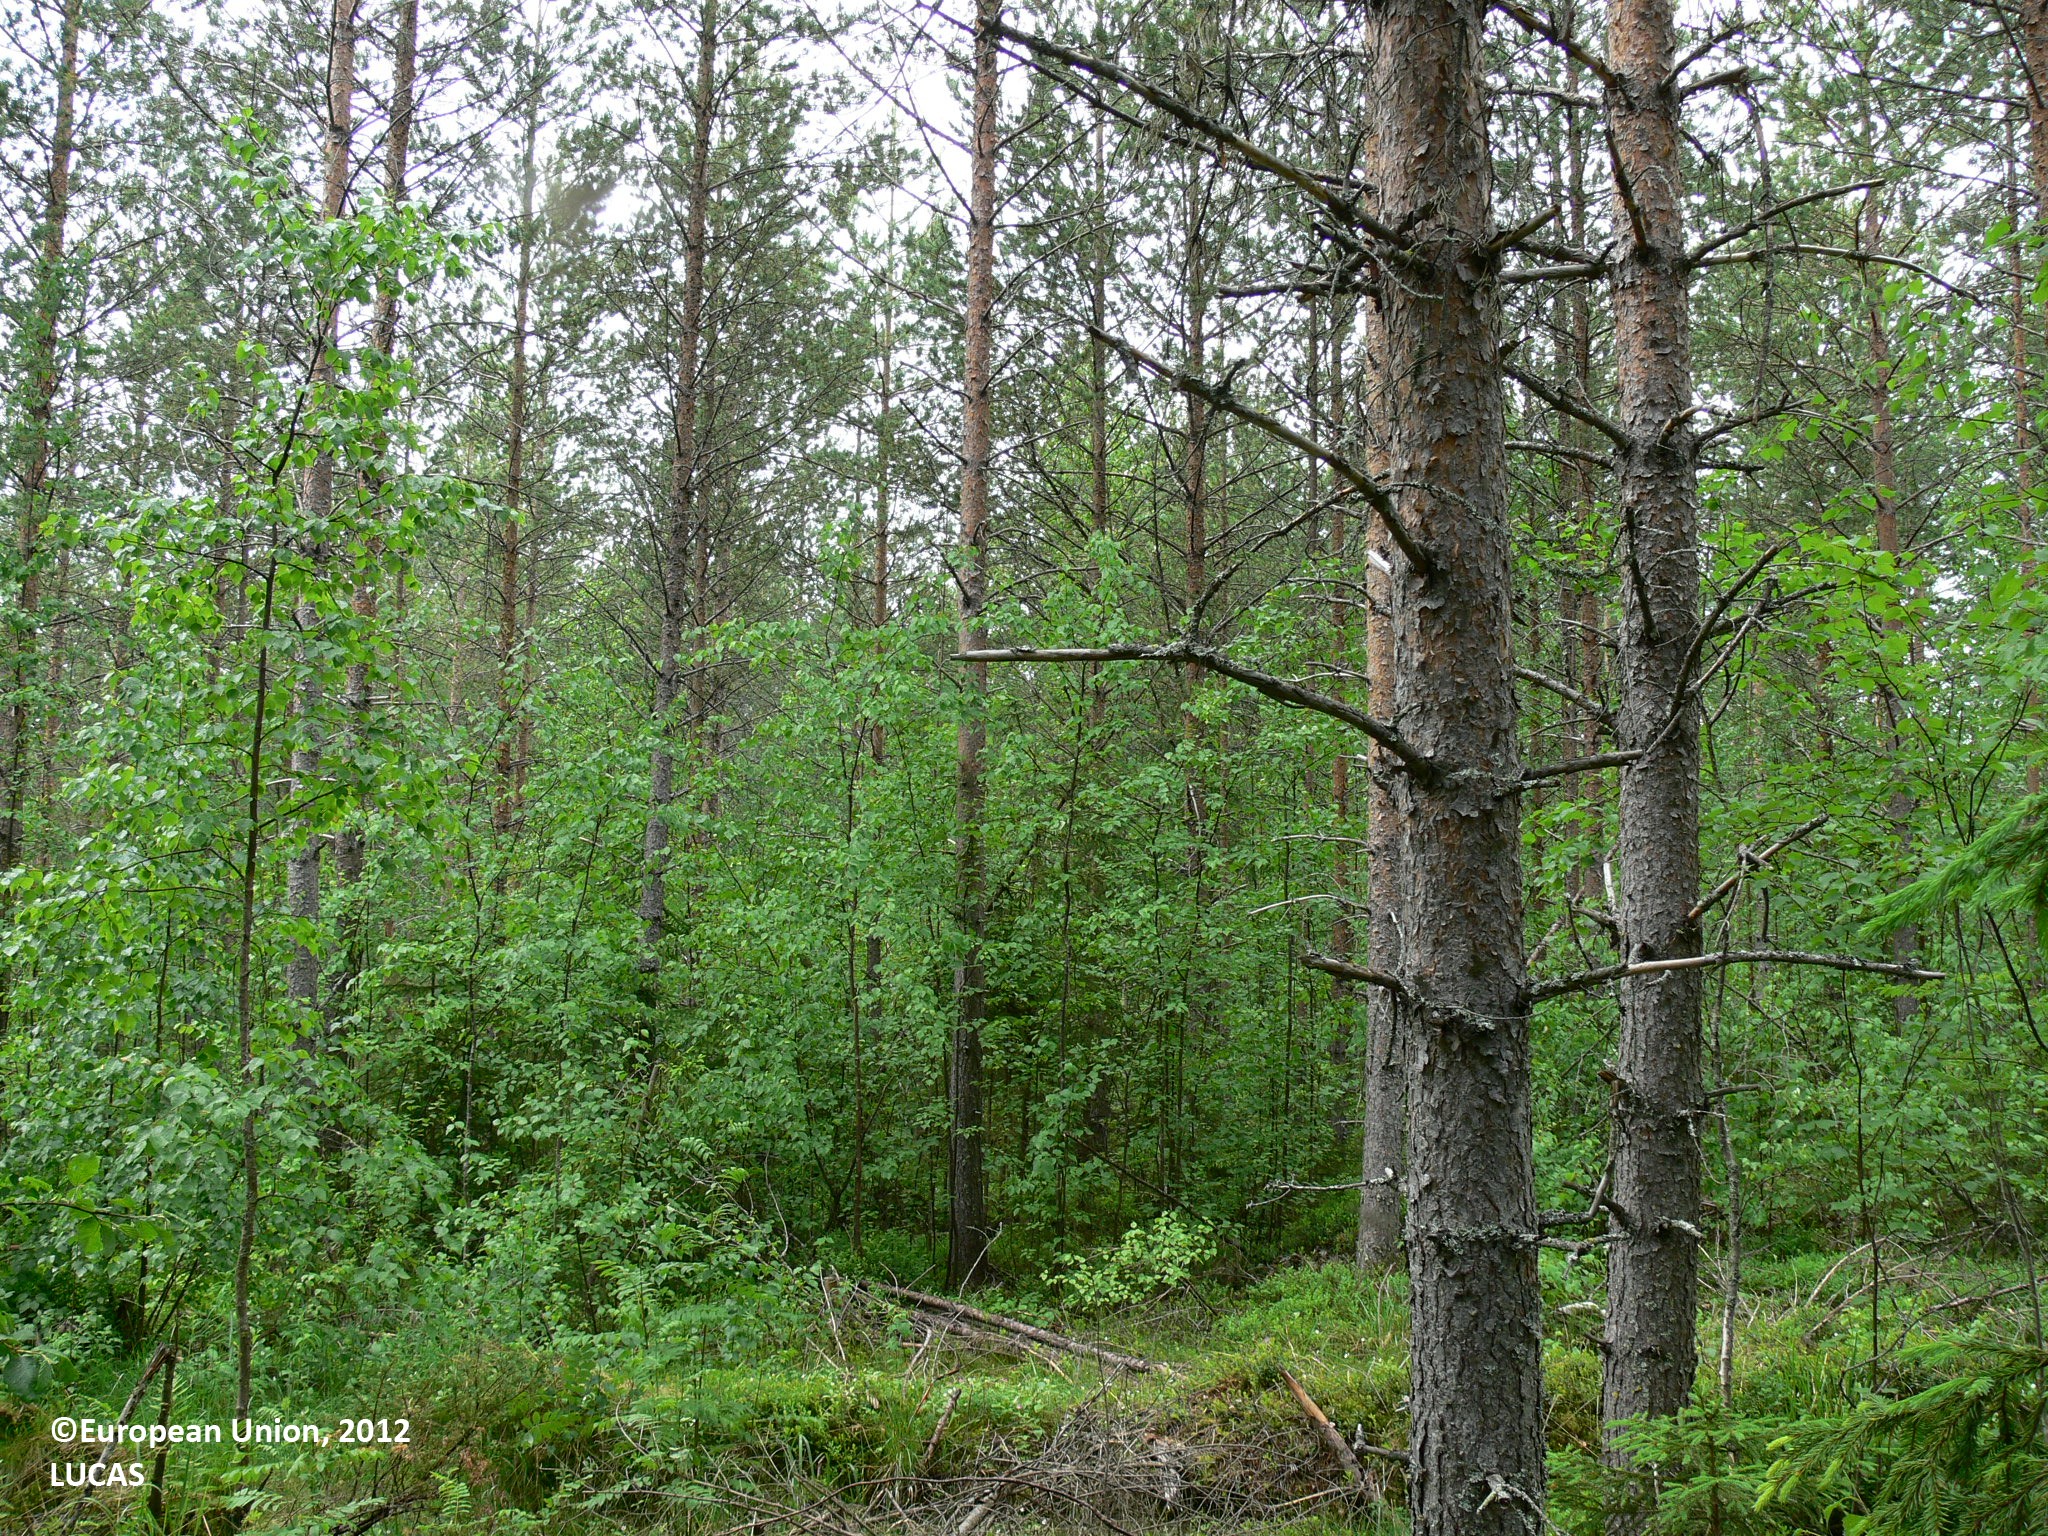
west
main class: Woodland
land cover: Pine dominated coniferous woodland
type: boreal forest
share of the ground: > 75 %
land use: Forestry
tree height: > 5 m
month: June
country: FI
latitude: 62.9319
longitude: 29.7247
